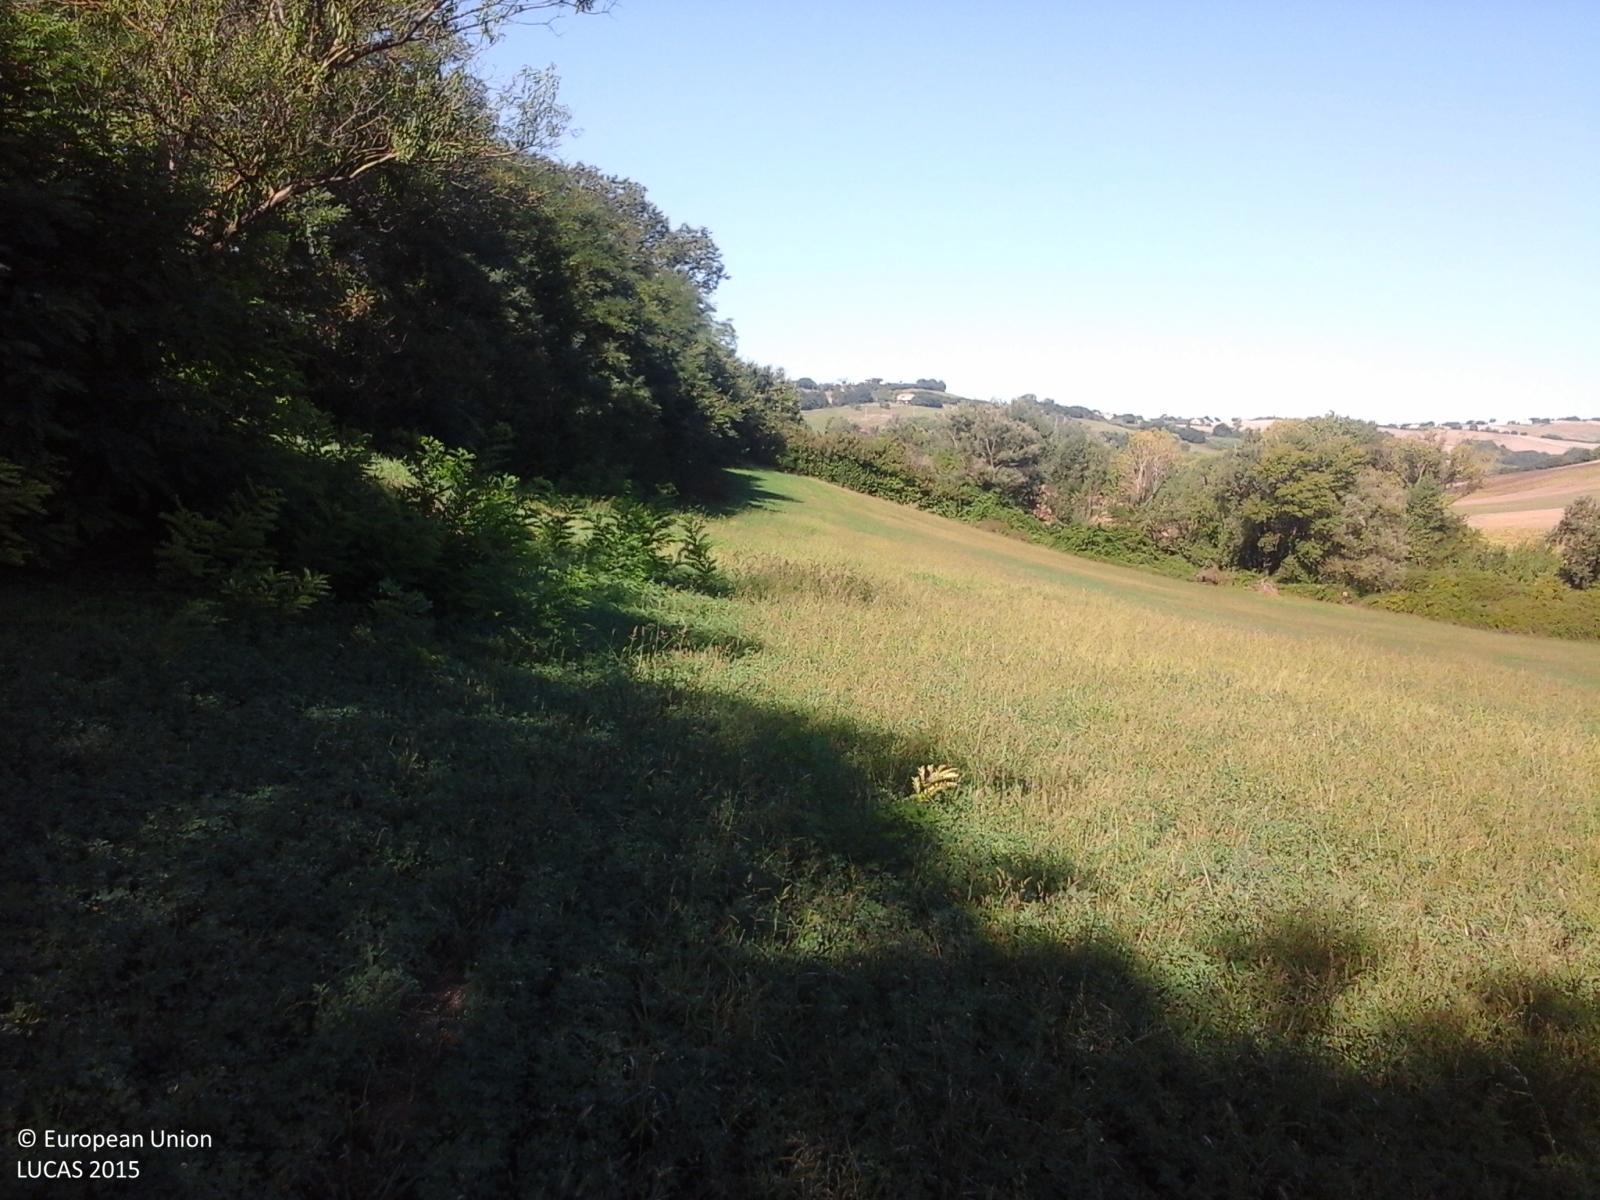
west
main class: Cropland
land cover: Lucerne
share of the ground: > 75 %
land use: Agriculture (excluding fallow land and kitchen gardens)
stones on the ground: < 10 %
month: September
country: IT
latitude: 43.6707
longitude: 13.1551
